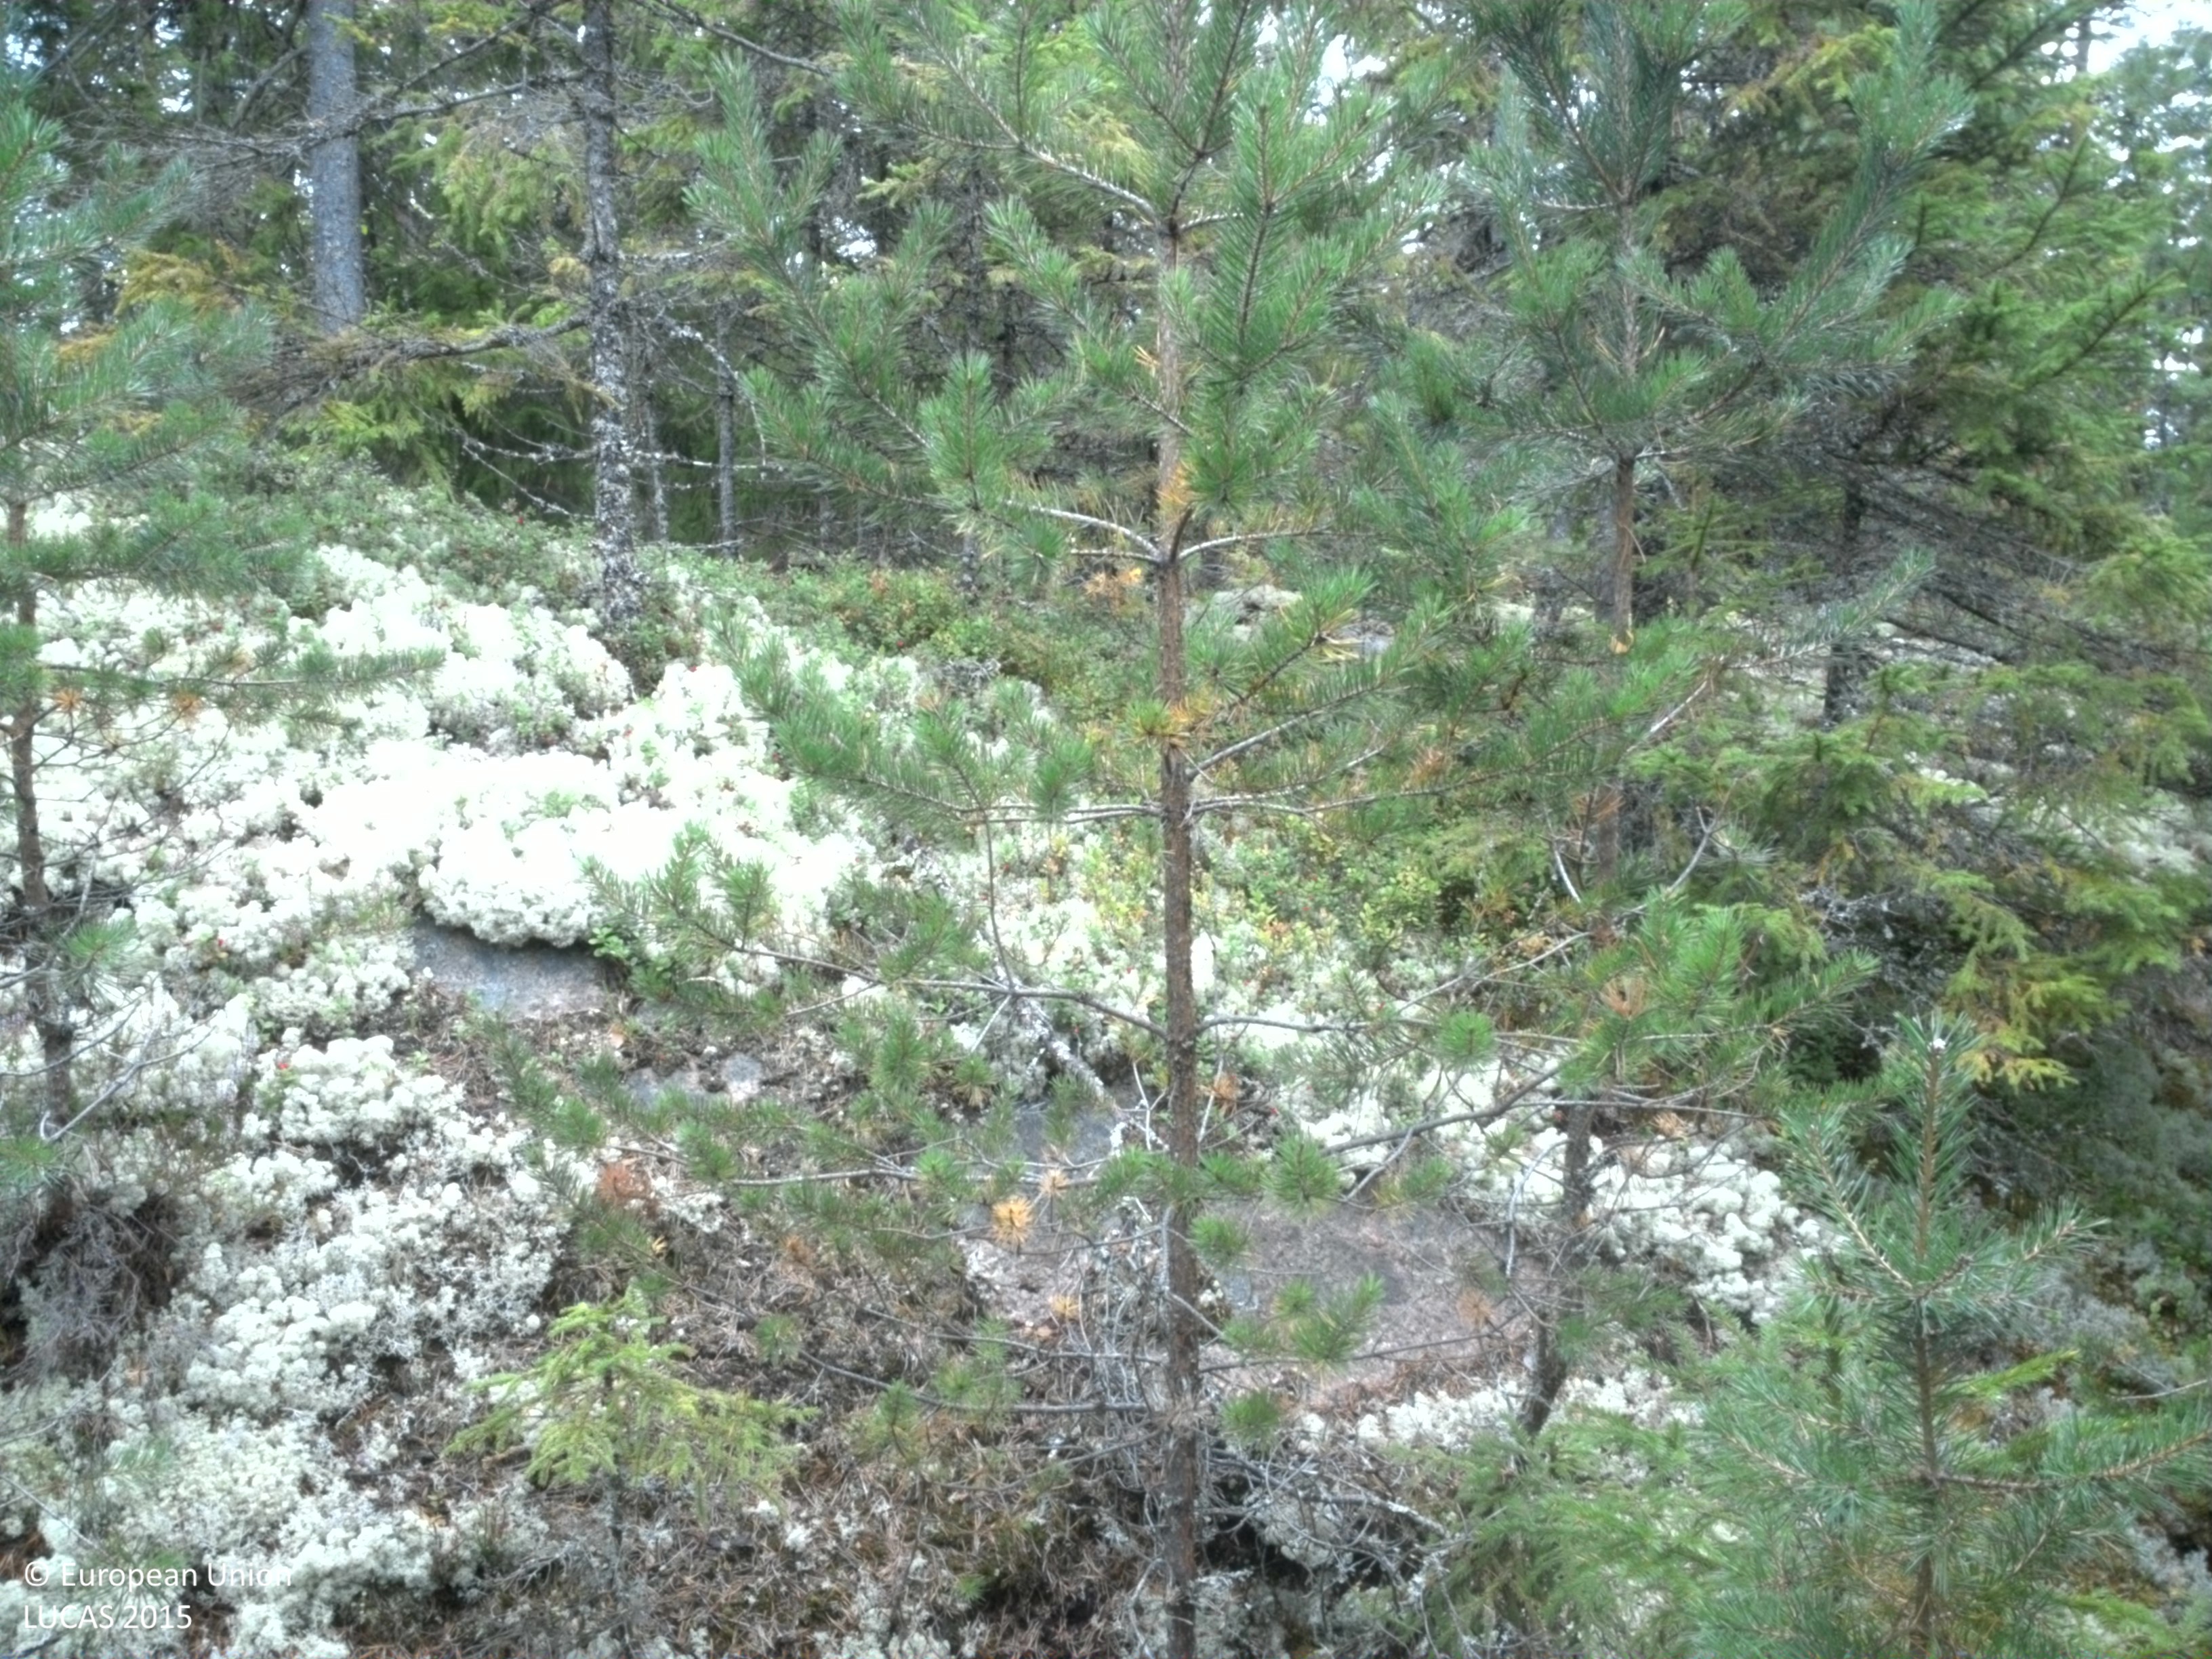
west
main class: Woodland
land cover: Pine dominated coniferous woodland
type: boreal forest
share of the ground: > 75 %
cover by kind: coniferous forest trees 80 %, shrubs 10 %, lichens and mosses 10 %
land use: Forestry
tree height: > 5 m
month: August
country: SE
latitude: 59.7613
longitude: 15.6336
